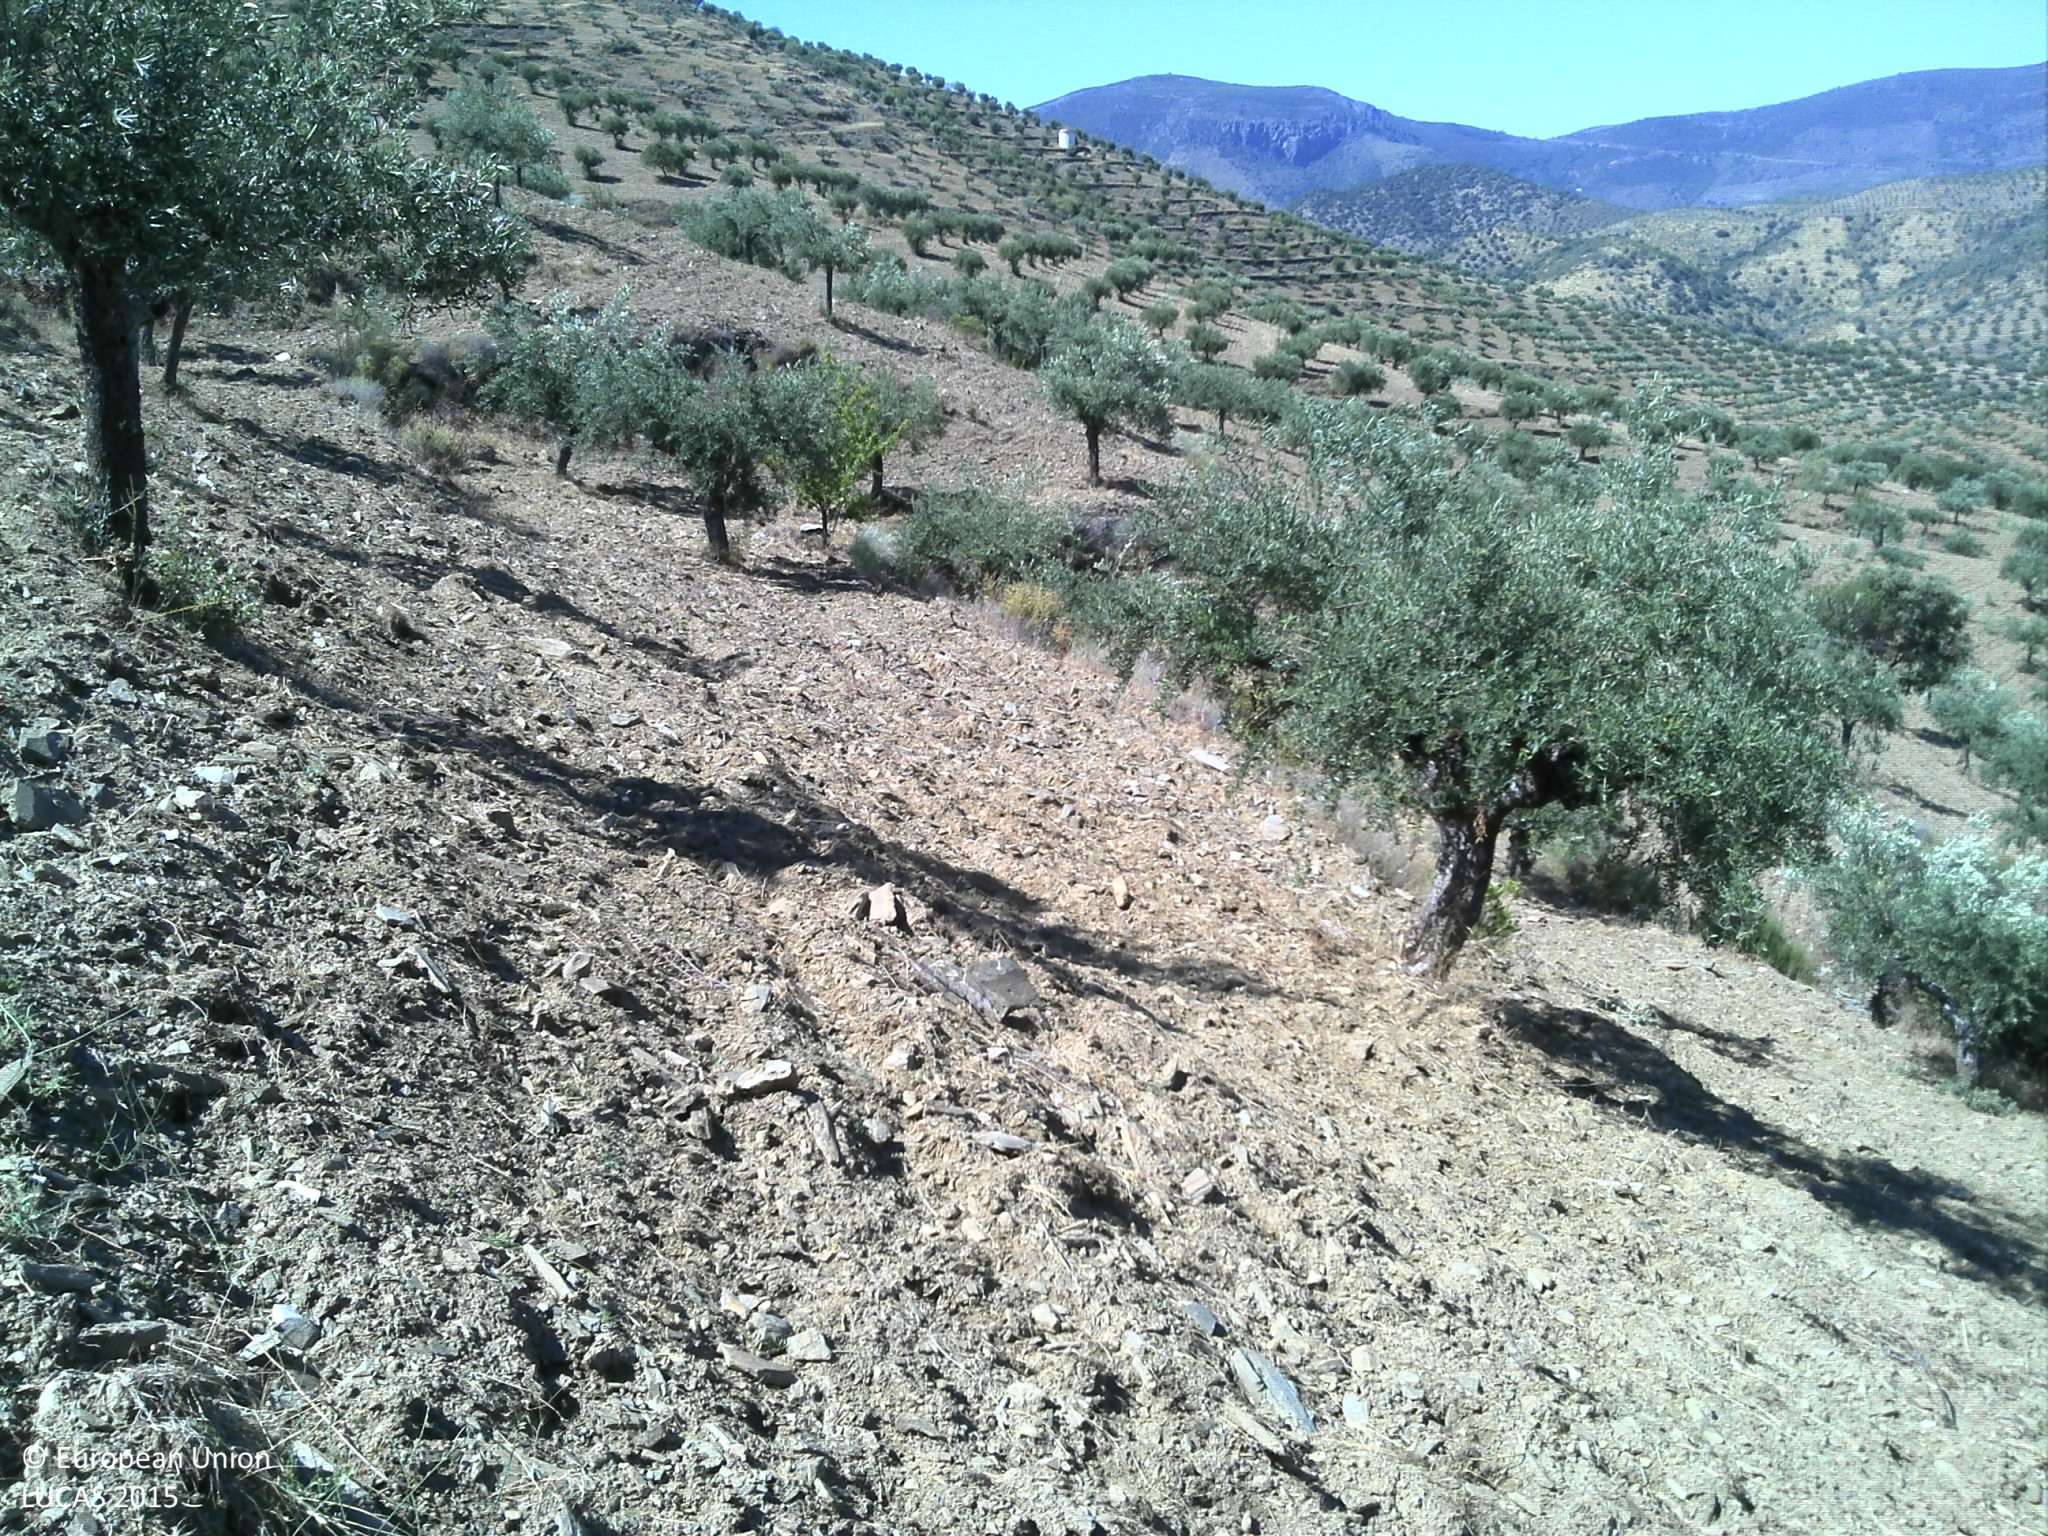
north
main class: Cropland
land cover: Olive groves
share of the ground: < 10 %
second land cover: Other bare soil
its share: > 75 %
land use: Agriculture (excluding fallow land and kitchen gardens)
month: June
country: PT
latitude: 41.0057
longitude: -6.9776
